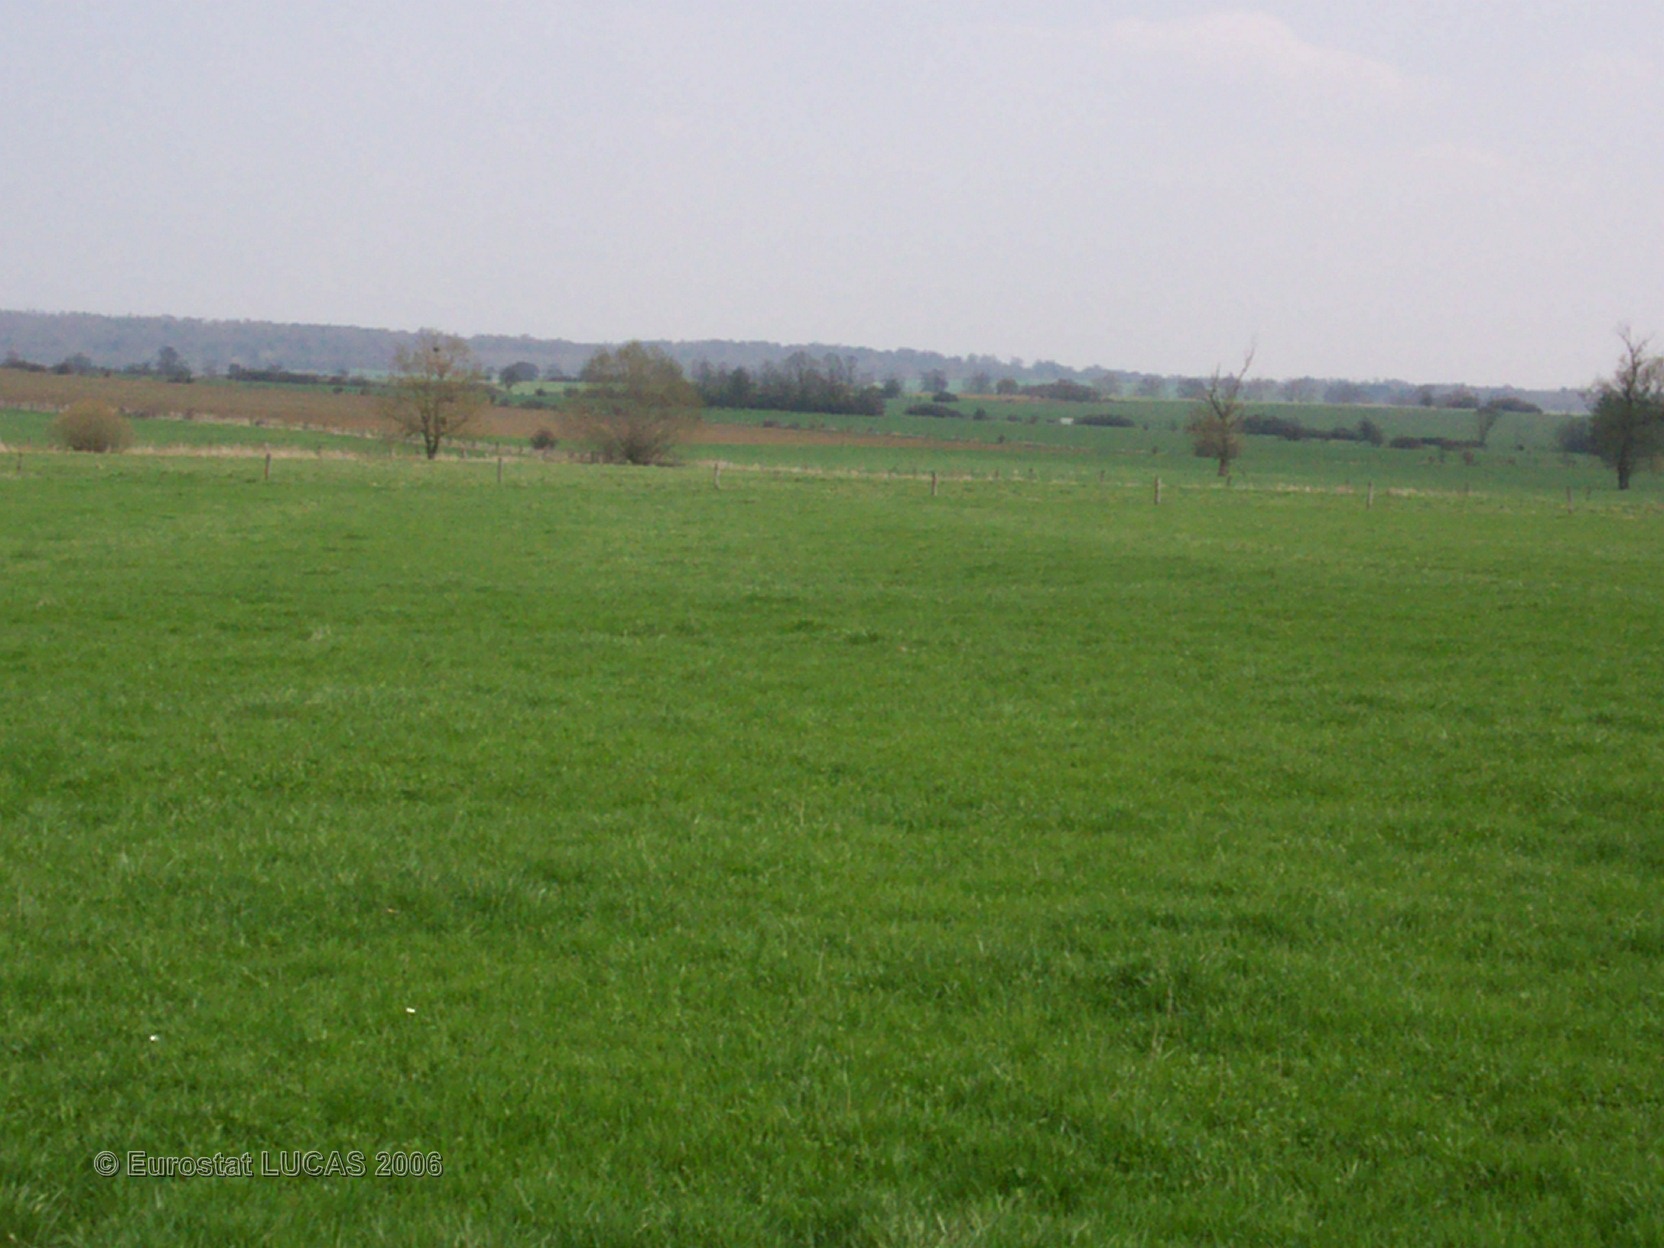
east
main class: Grassland
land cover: Grassland without tree/shrub cover
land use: Agriculture (excluding fallow land and kitchen gardens)
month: April
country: FR
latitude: 48.7780
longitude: 5.9035
